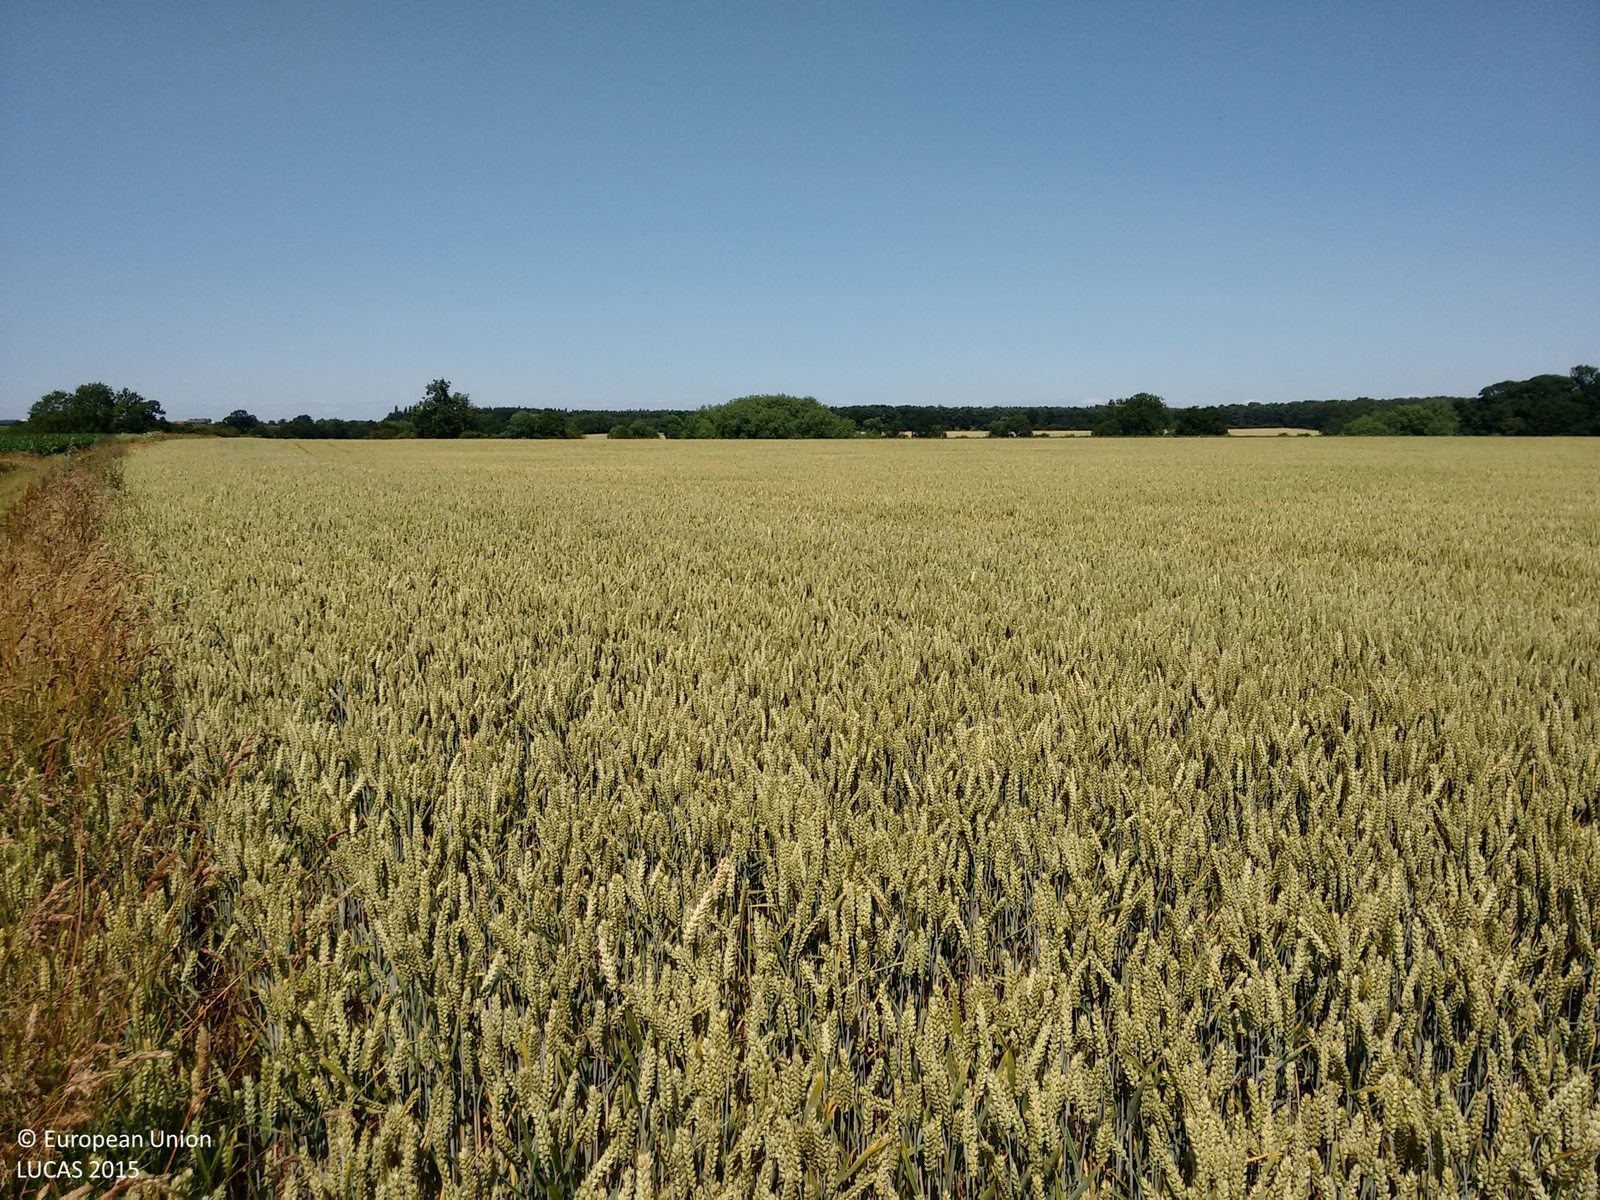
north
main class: Cropland
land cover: Common wheat
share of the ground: > 75 %
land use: Agriculture (excluding fallow land and kitchen gardens)
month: July
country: GB
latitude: 53.2469
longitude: -0.9682
